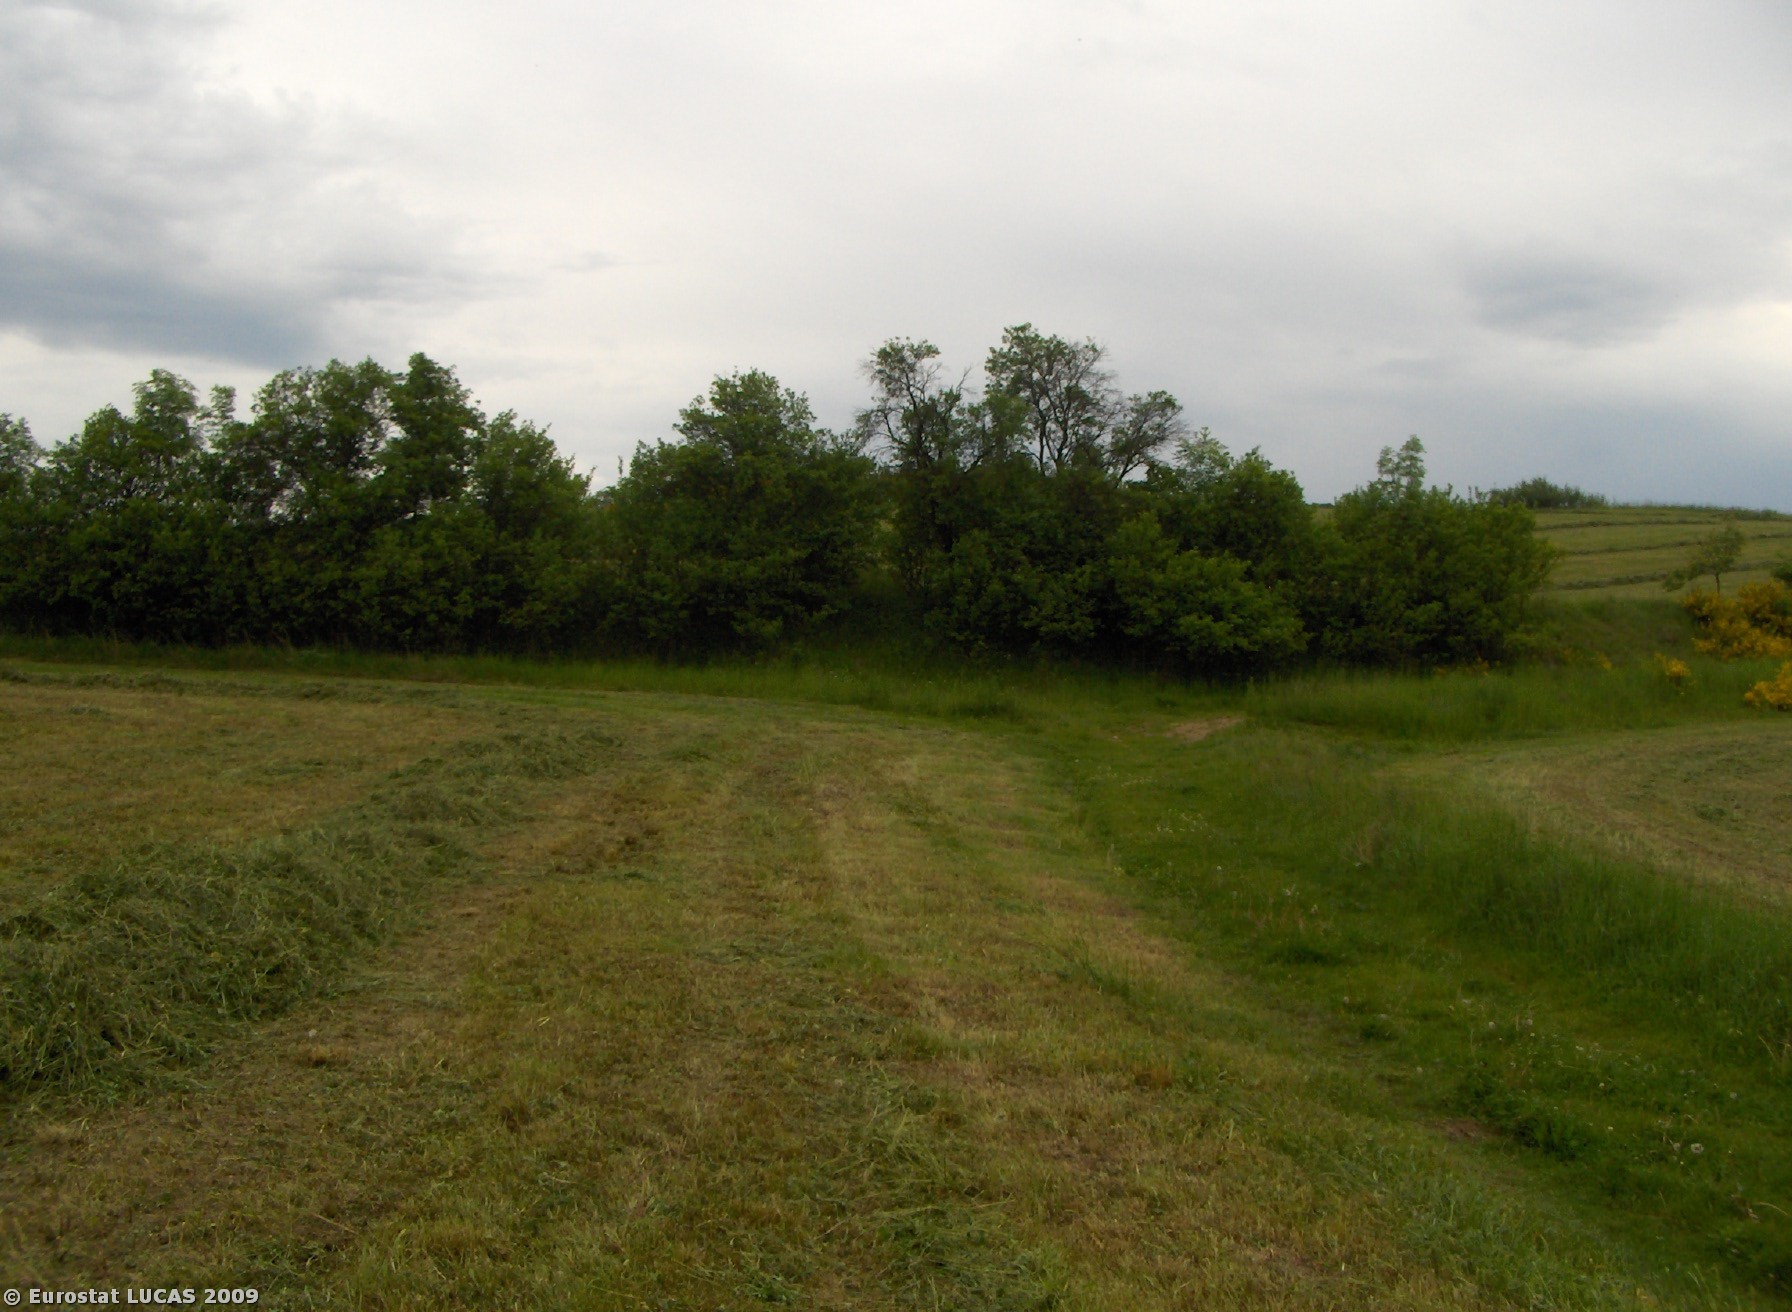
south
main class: Cropland
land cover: Clovers
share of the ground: > 75 %
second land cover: Grassland without tree/shrub cover
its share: 10 - 25 %
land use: Agriculture (excluding fallow land and kitchen gardens)
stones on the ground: < 10 %
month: May
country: CZ
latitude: 49.5491
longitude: 14.1890
